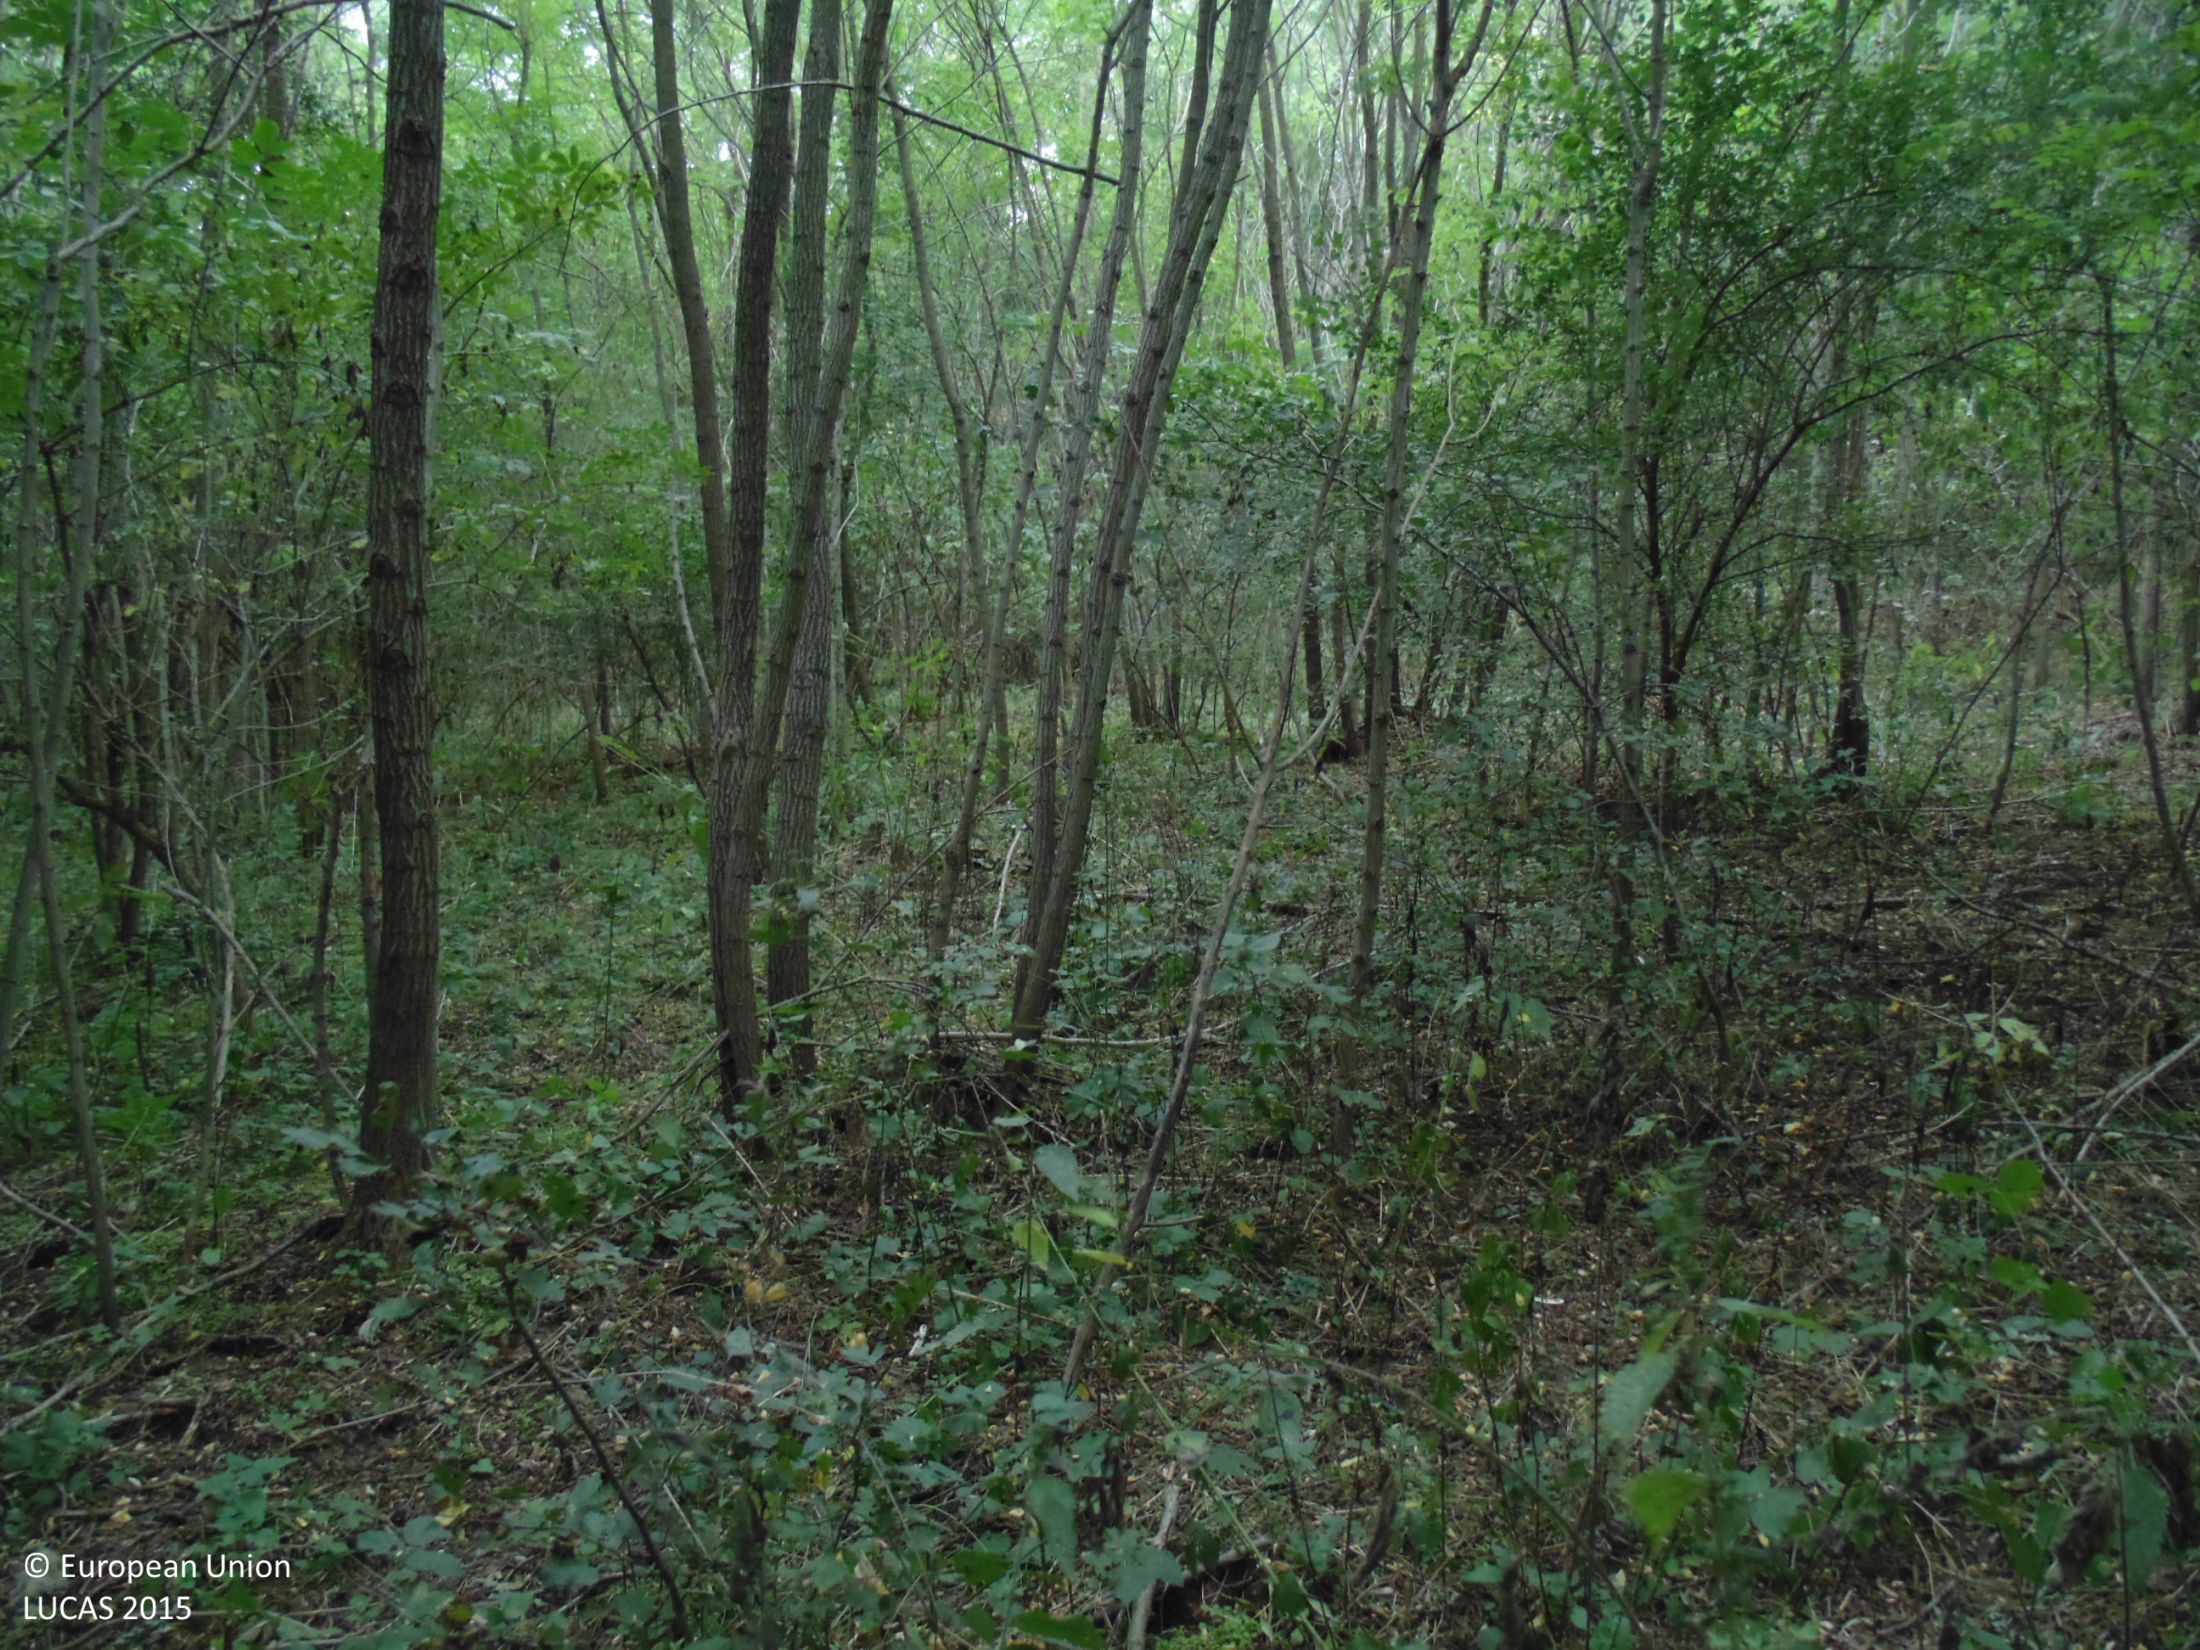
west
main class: Woodland
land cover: Broadleaved woodland
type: mesophytic deciduous forest
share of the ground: > 75 %
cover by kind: broadleaved forest trees 90 %, shrubs 5 %, unconsolidated bare surface 5 %
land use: Forestry
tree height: > 5 m
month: September
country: BG
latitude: 44.0245
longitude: 26.9781
